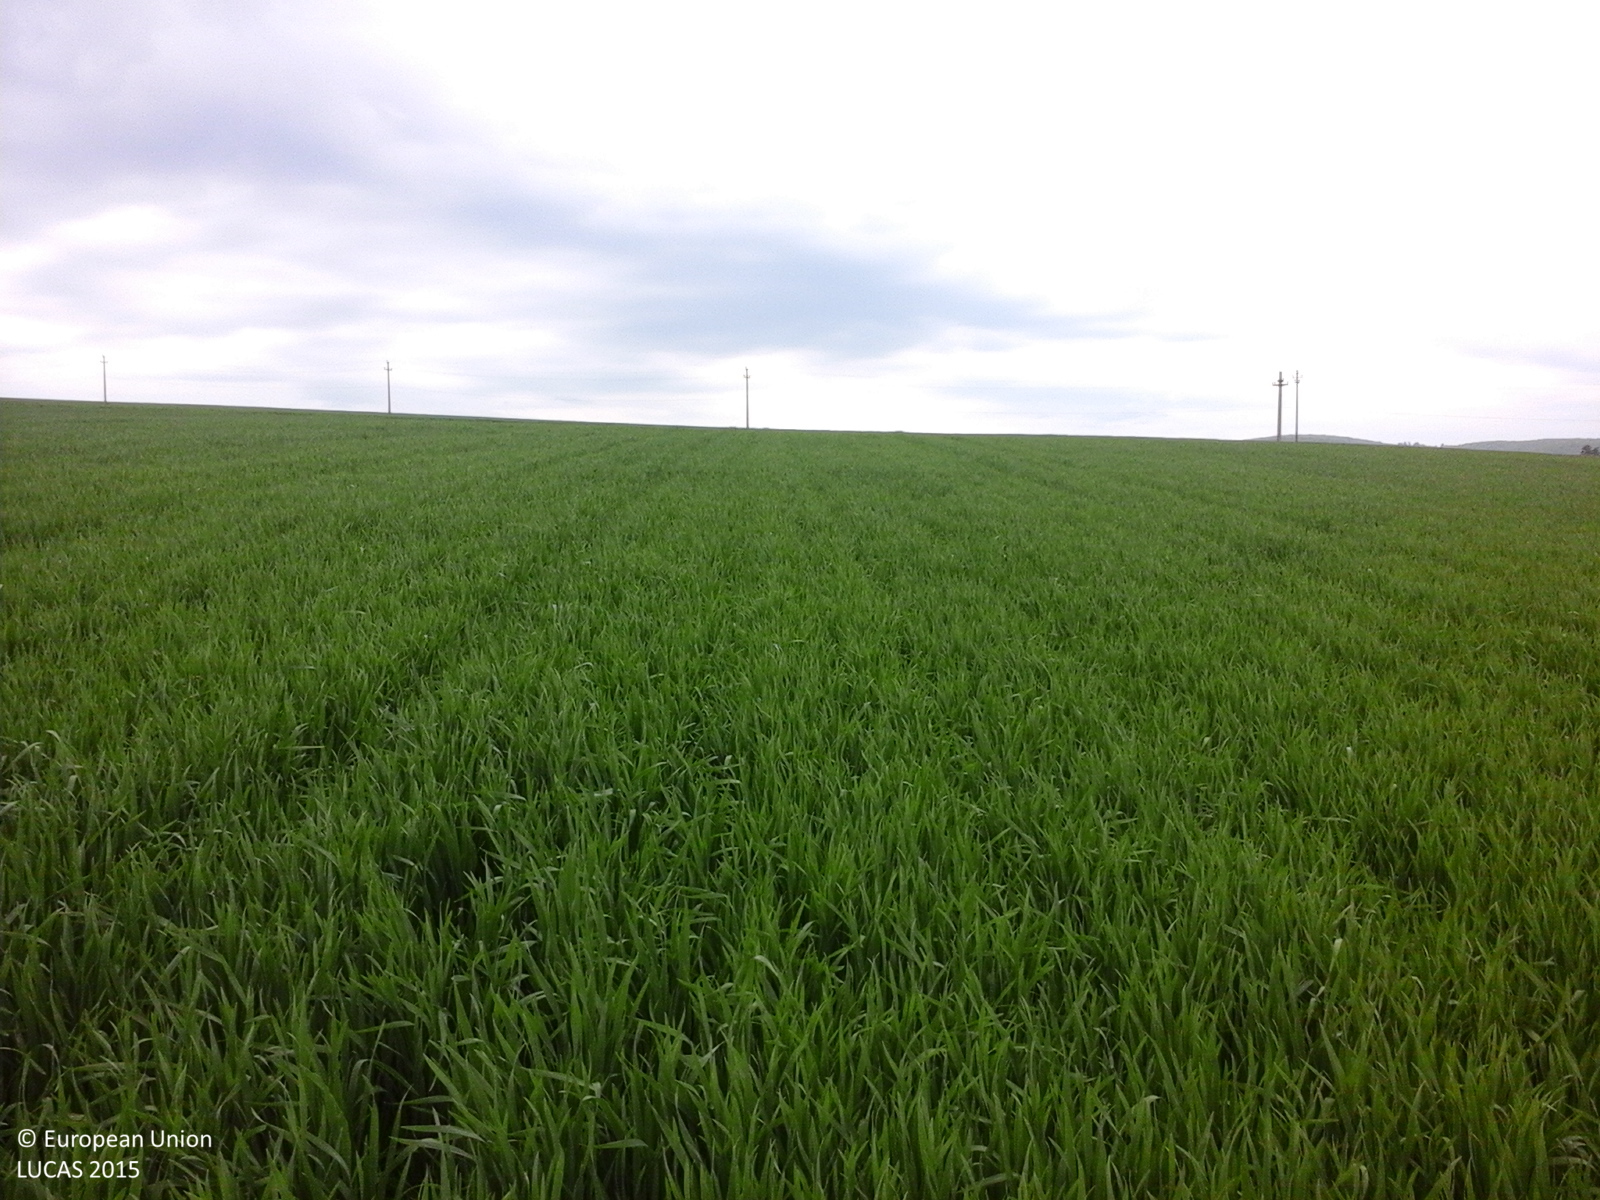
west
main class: Cropland
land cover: Common wheat
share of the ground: > 75 %
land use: Agriculture (excluding fallow land and kitchen gardens)
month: May
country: RO
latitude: 45.9059
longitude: 26.0106
